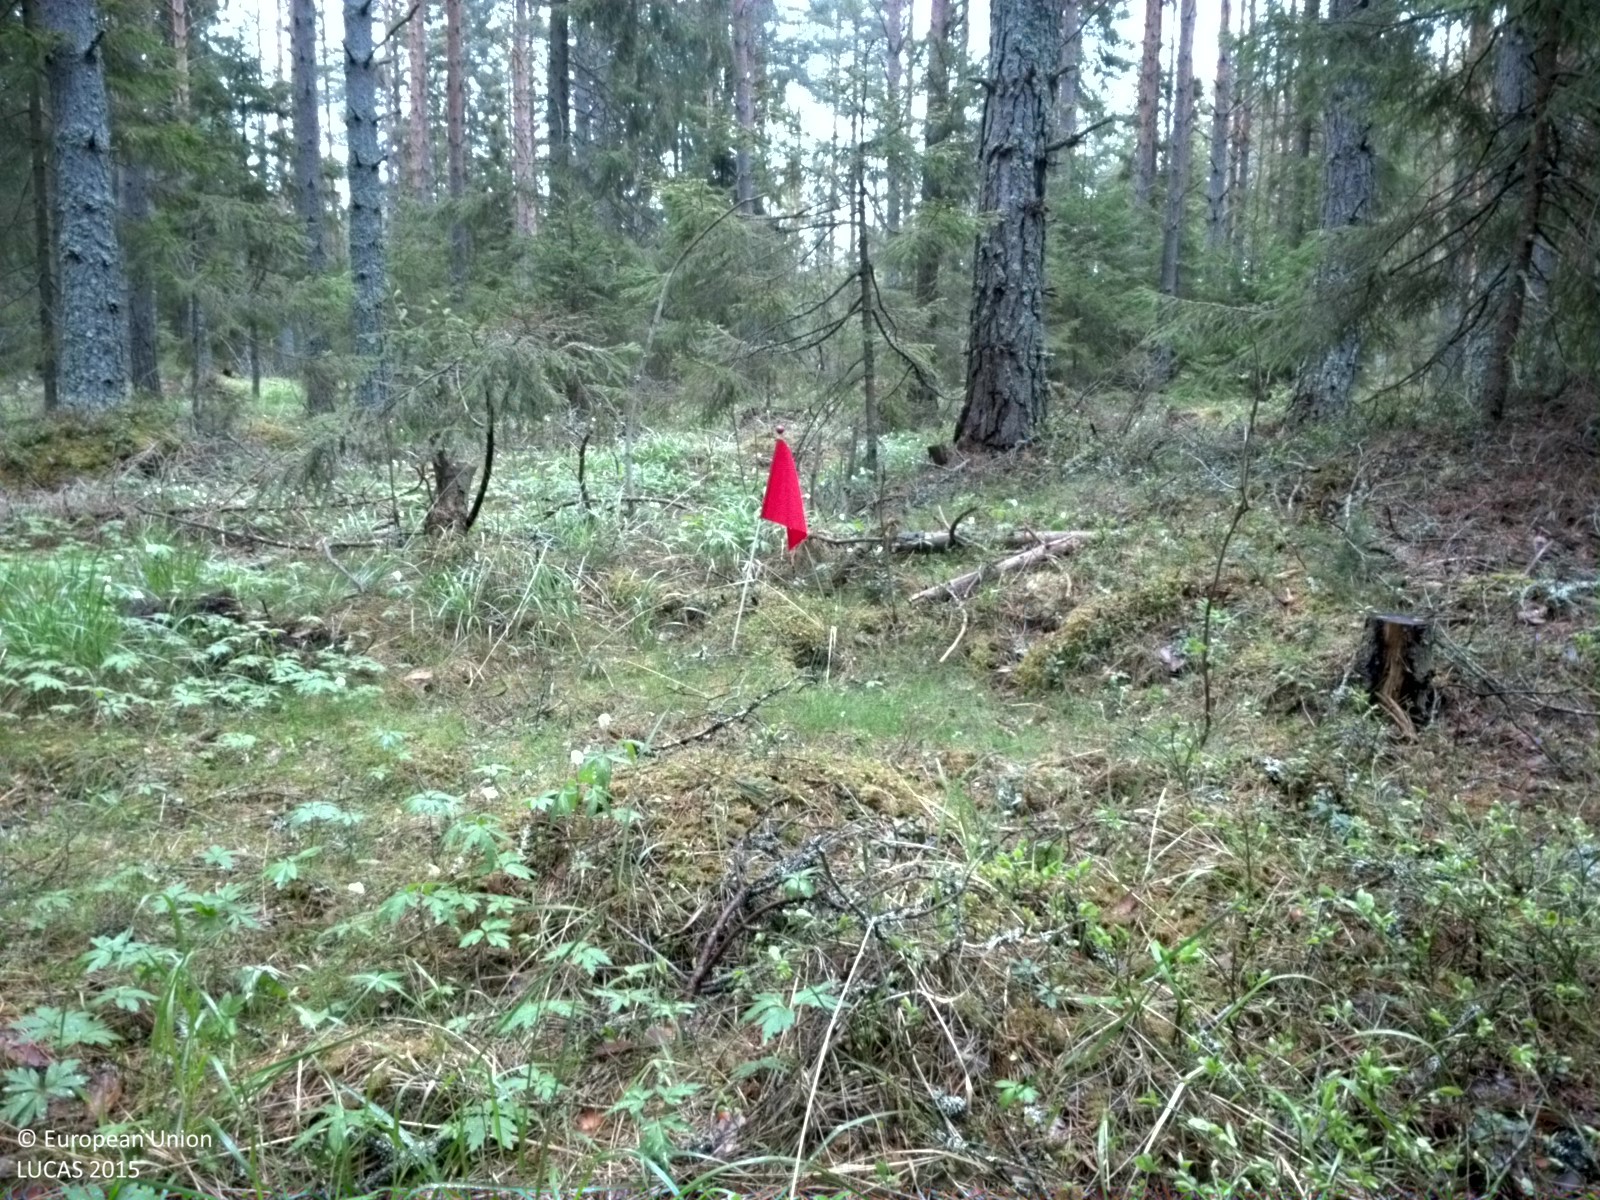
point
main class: Woodland
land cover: Spruce dominated coniferous woodland
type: boreal forest
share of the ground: 50 - 75 %
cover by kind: coniferous forest trees 55 %, herbaceous plants 25 %, shrubs 15 %, lichens and mosses 5 %
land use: Forestry
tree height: > 5 m
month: May
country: SE
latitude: 60.2392
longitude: 18.0674
